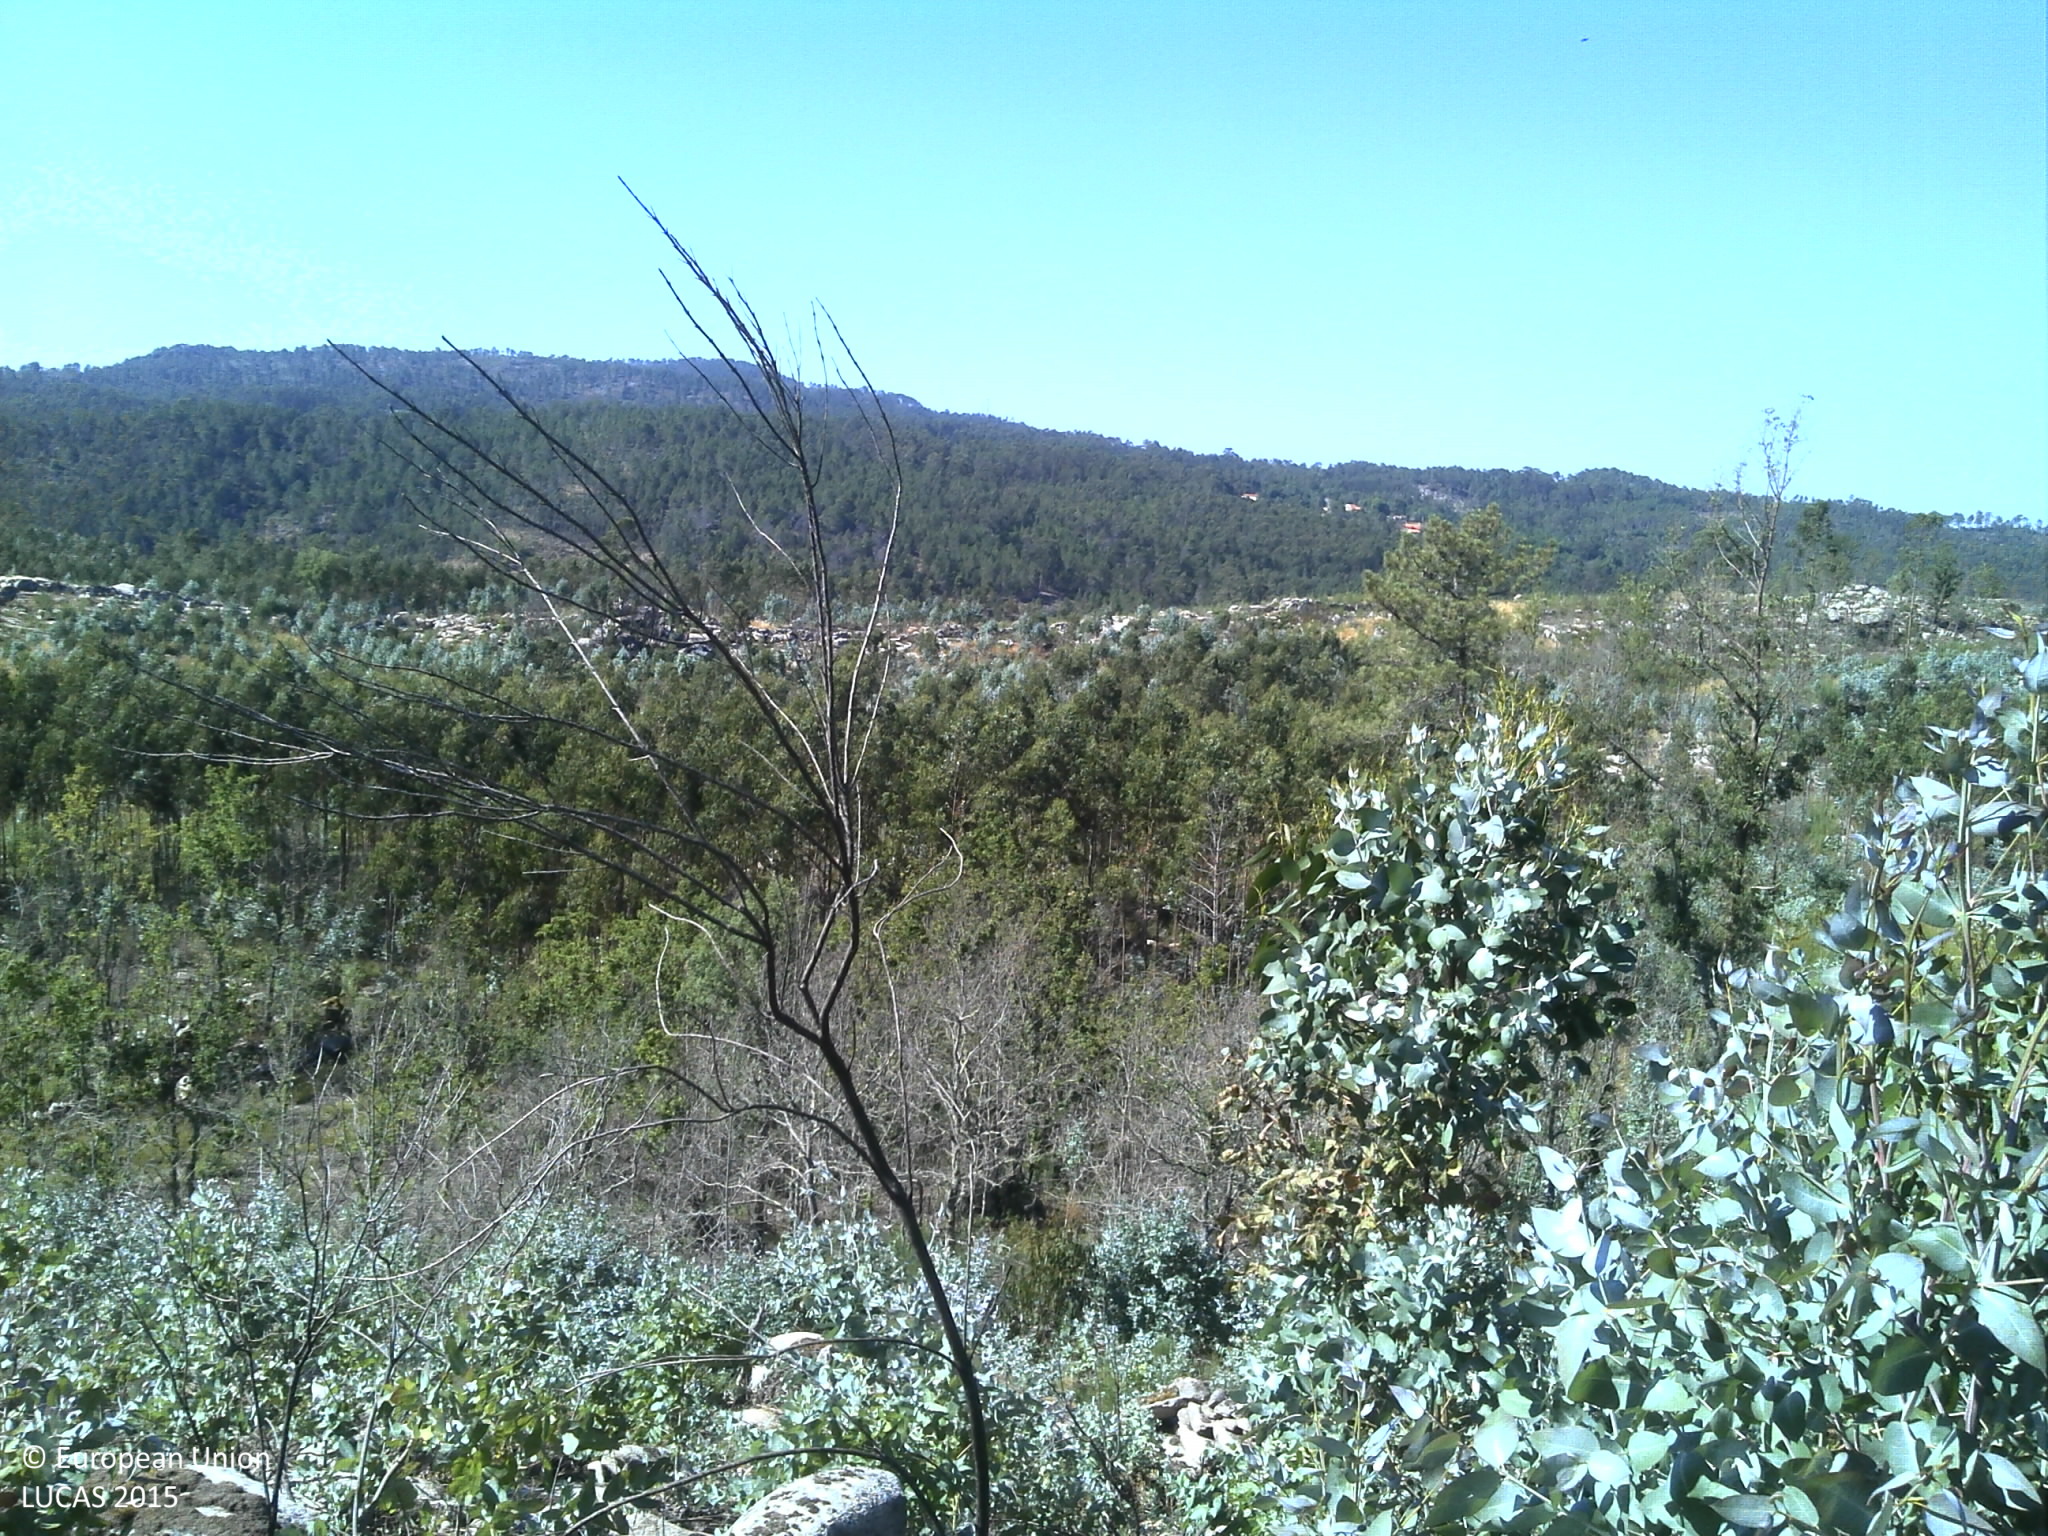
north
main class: Woodland
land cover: Broadleaved woodland
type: exotic forest
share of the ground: 25 - 50 %
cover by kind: broadleaved forest trees 50 %, unconsolidated bare surface 25 %, consolidated bare surface 20 %, shrubs 5 %
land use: Forestry
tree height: < 5 m
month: June
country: PT
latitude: 40.5919
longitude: -8.2461
